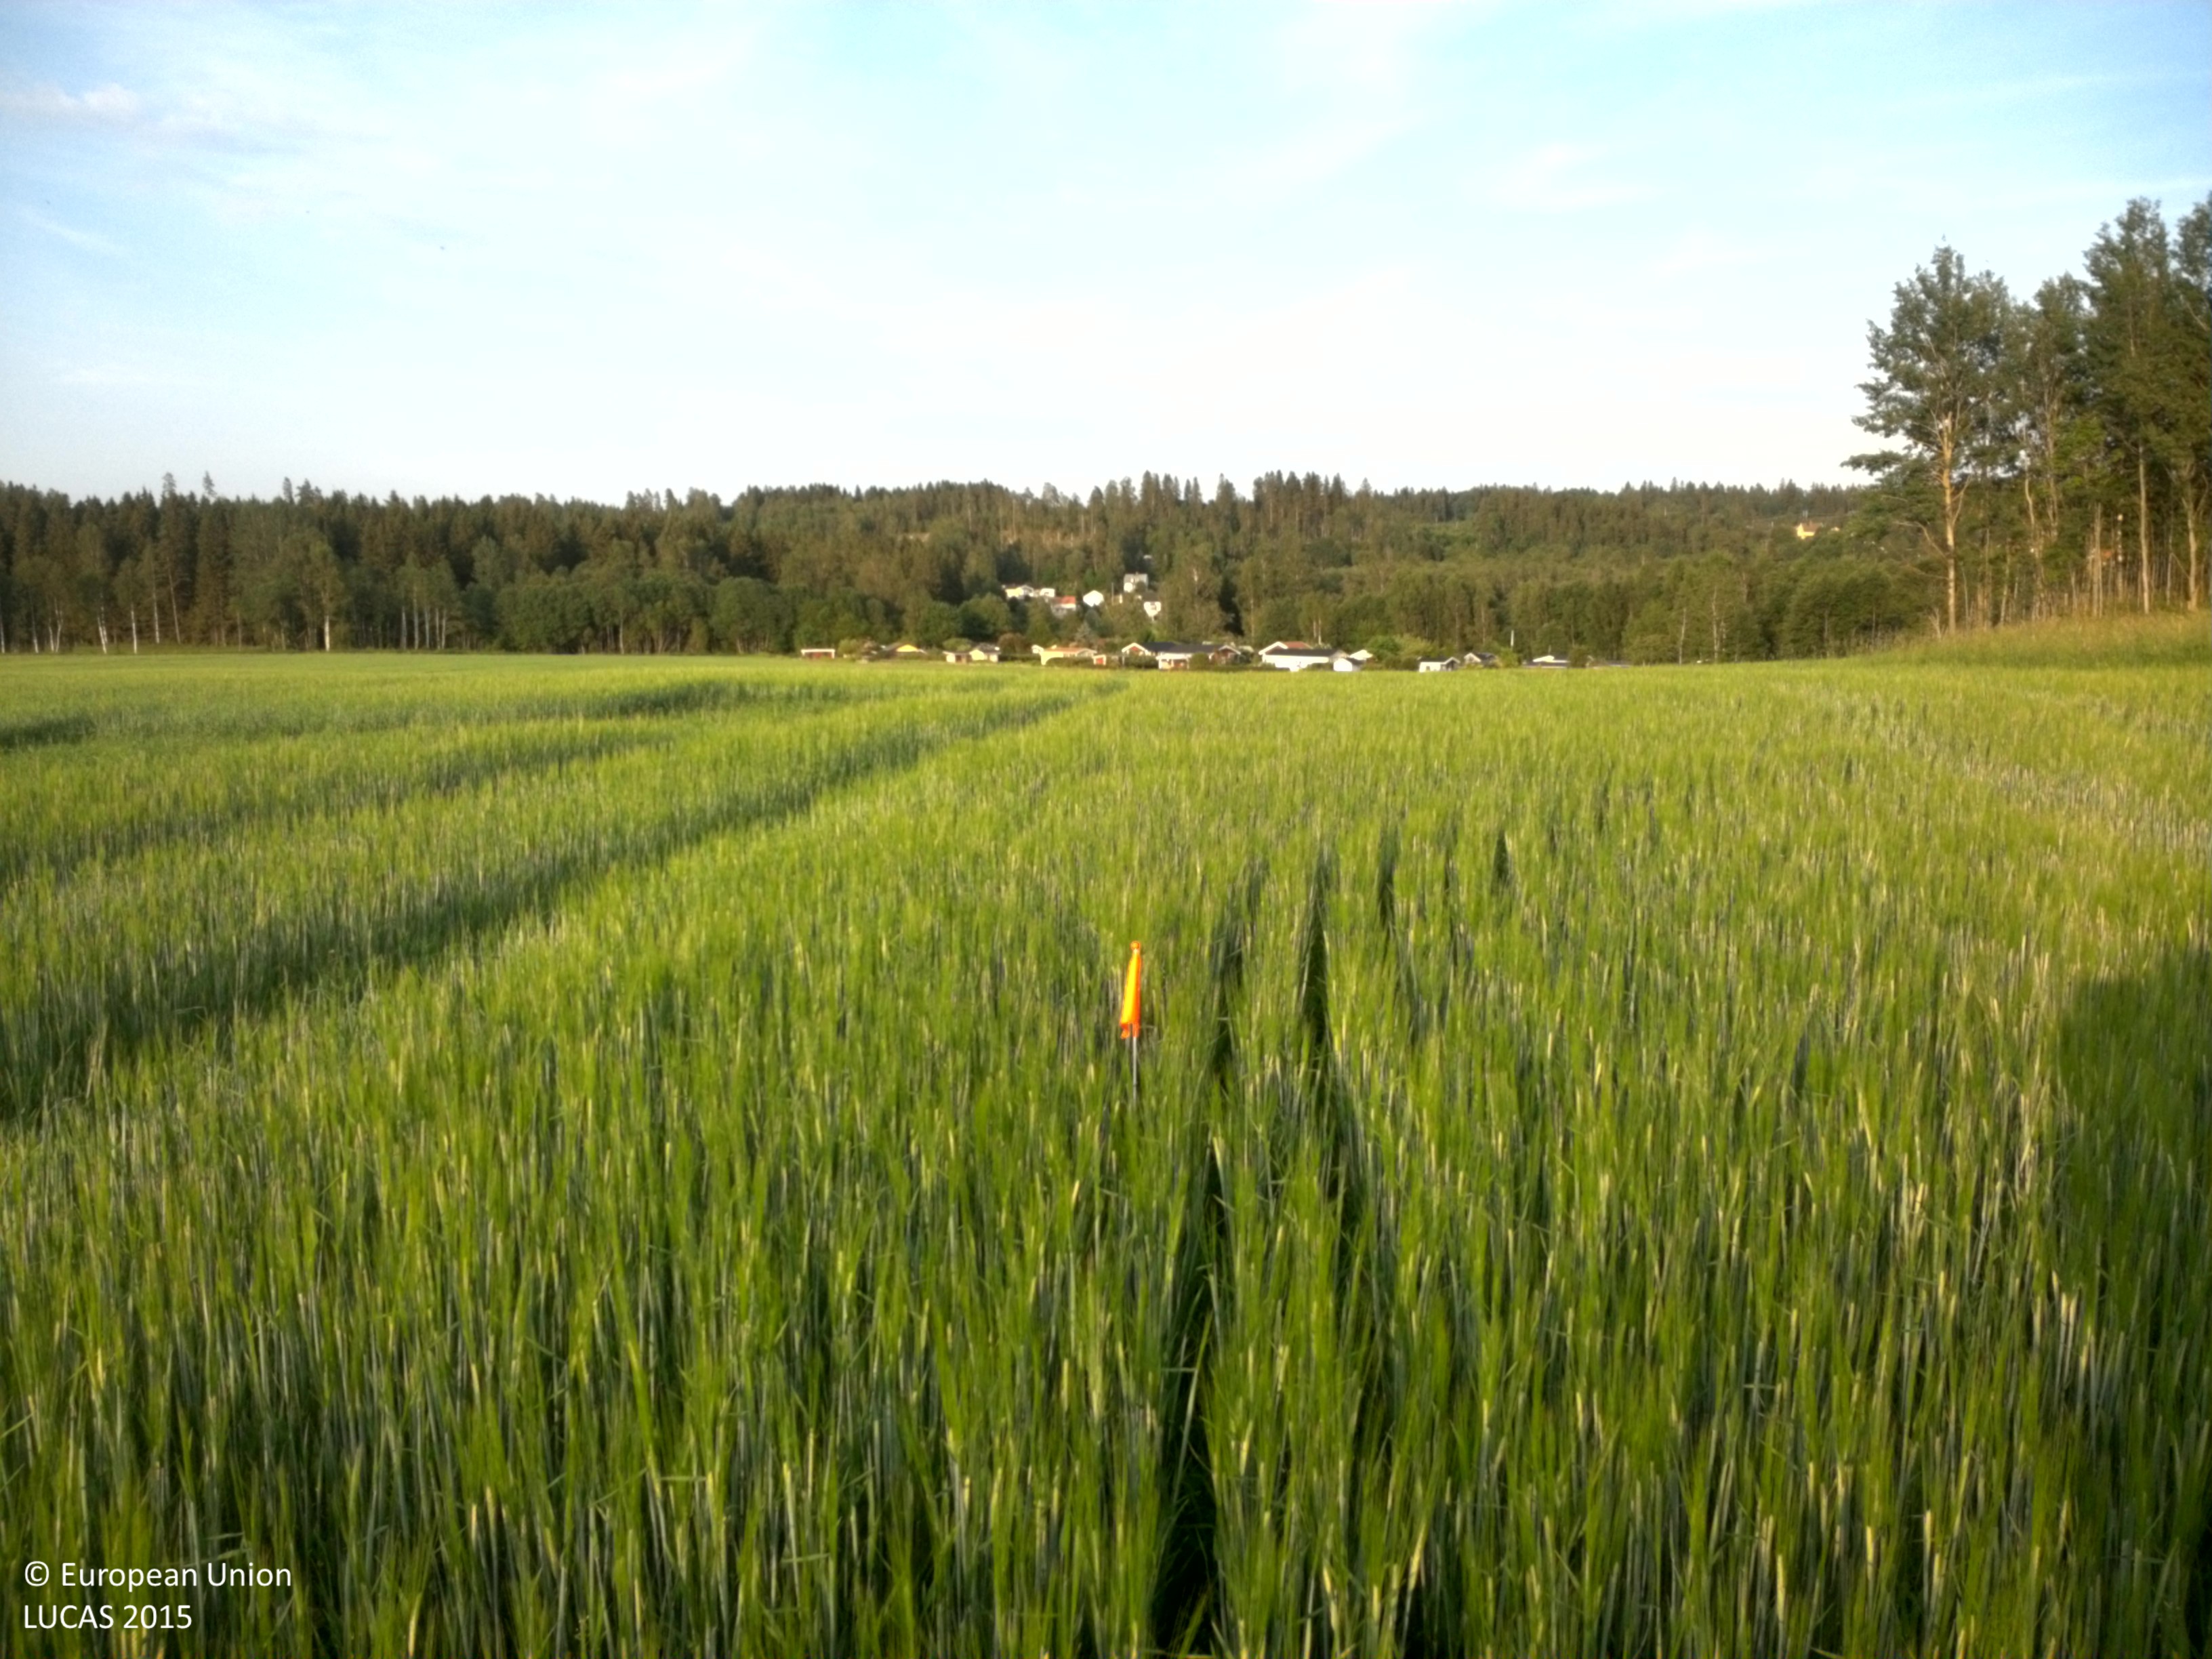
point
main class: Cropland
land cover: Barley
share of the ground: > 75 %
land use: Agriculture (excluding fallow land and kitchen gardens)
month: July
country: SE
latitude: 59.3311
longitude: 14.5789
